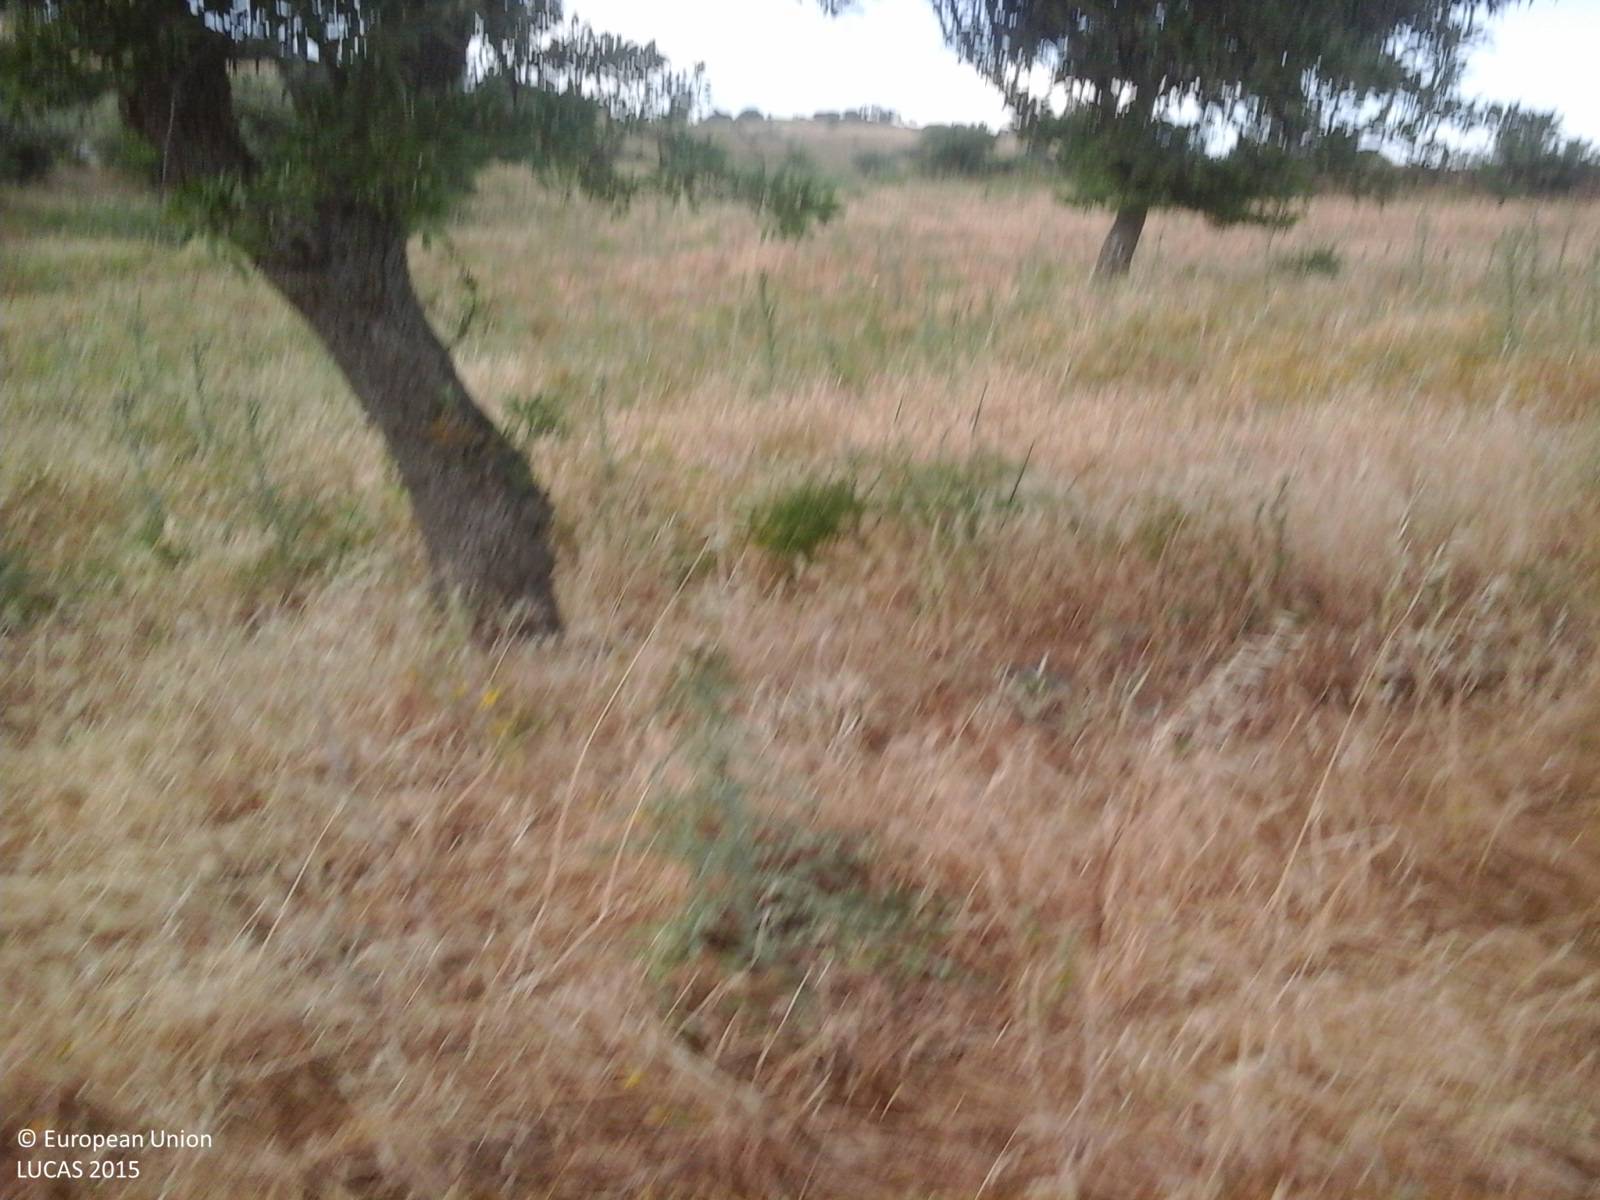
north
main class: Grassland
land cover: Grassland with sparse tree/shrub cover
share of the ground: > 75 %
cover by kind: herbaceous plants 95 %, broadleaved forest trees 5 %
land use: Agriculture (excluding fallow land and kitchen gardens)
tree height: > 5 m
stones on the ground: < 10 %
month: June
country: IT
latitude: 40.5010
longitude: 9.4247
